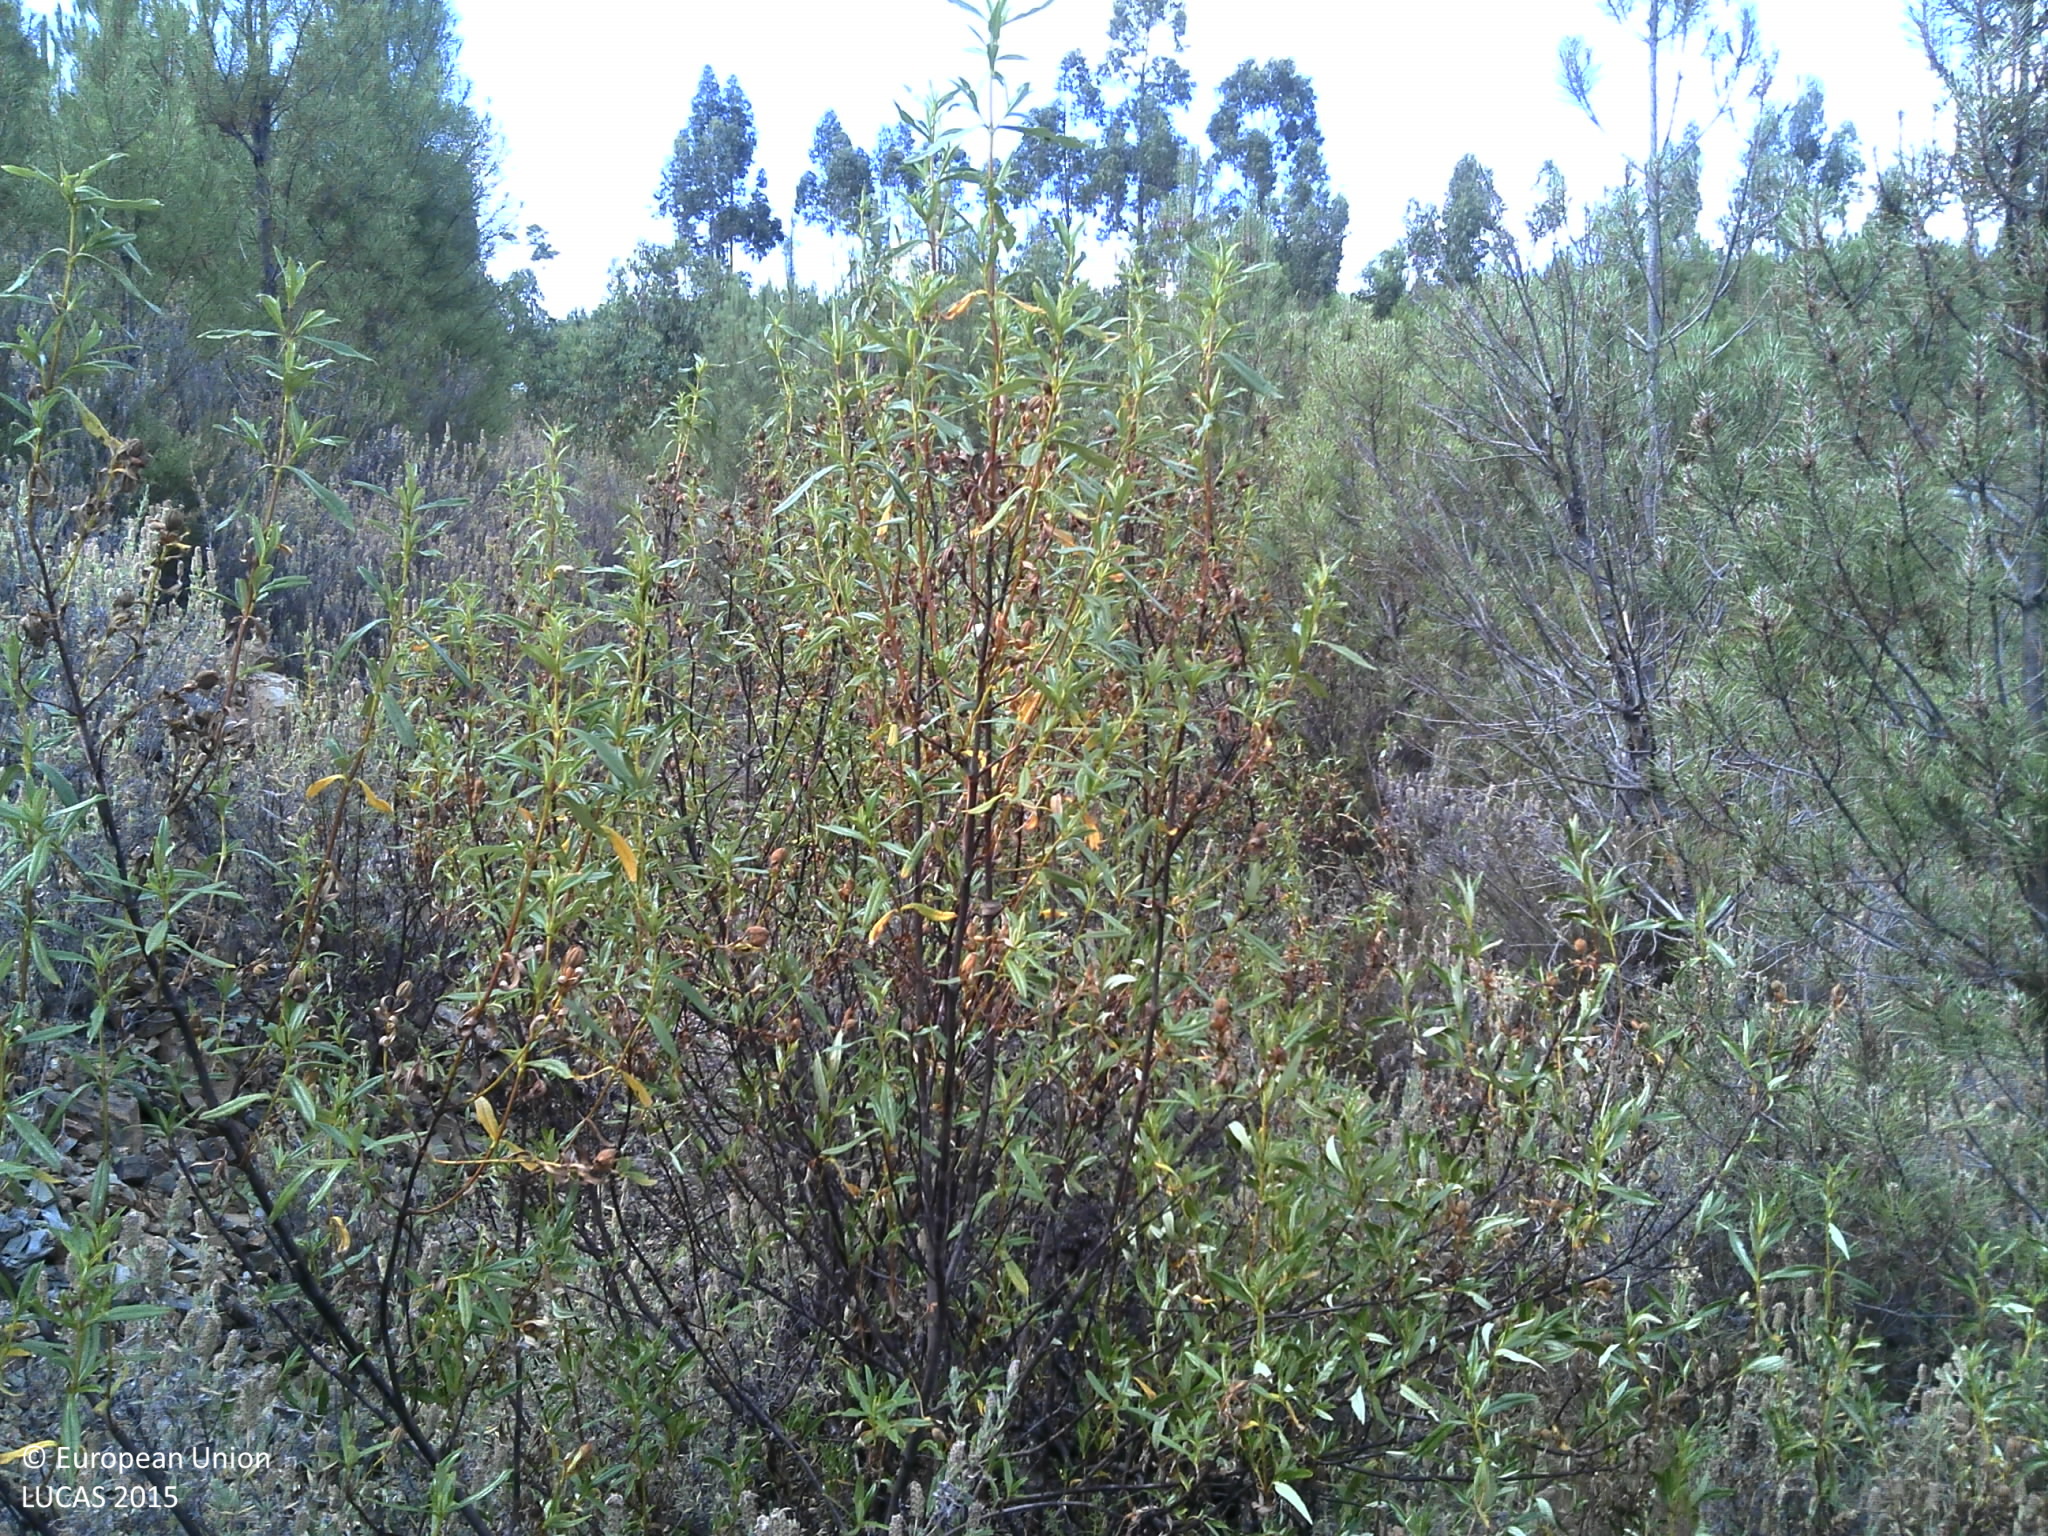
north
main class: Woodland
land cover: Pine dominated coniferous woodland
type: coniferous forest of the mediterranean region
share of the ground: 10 - 25 %
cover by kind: shrubs 60 %, unconsolidated bare surface 25 %, coniferous forest trees 15 %
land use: Forestry
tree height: < 5 m
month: July
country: PT
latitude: 39.6679
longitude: -8.0504
